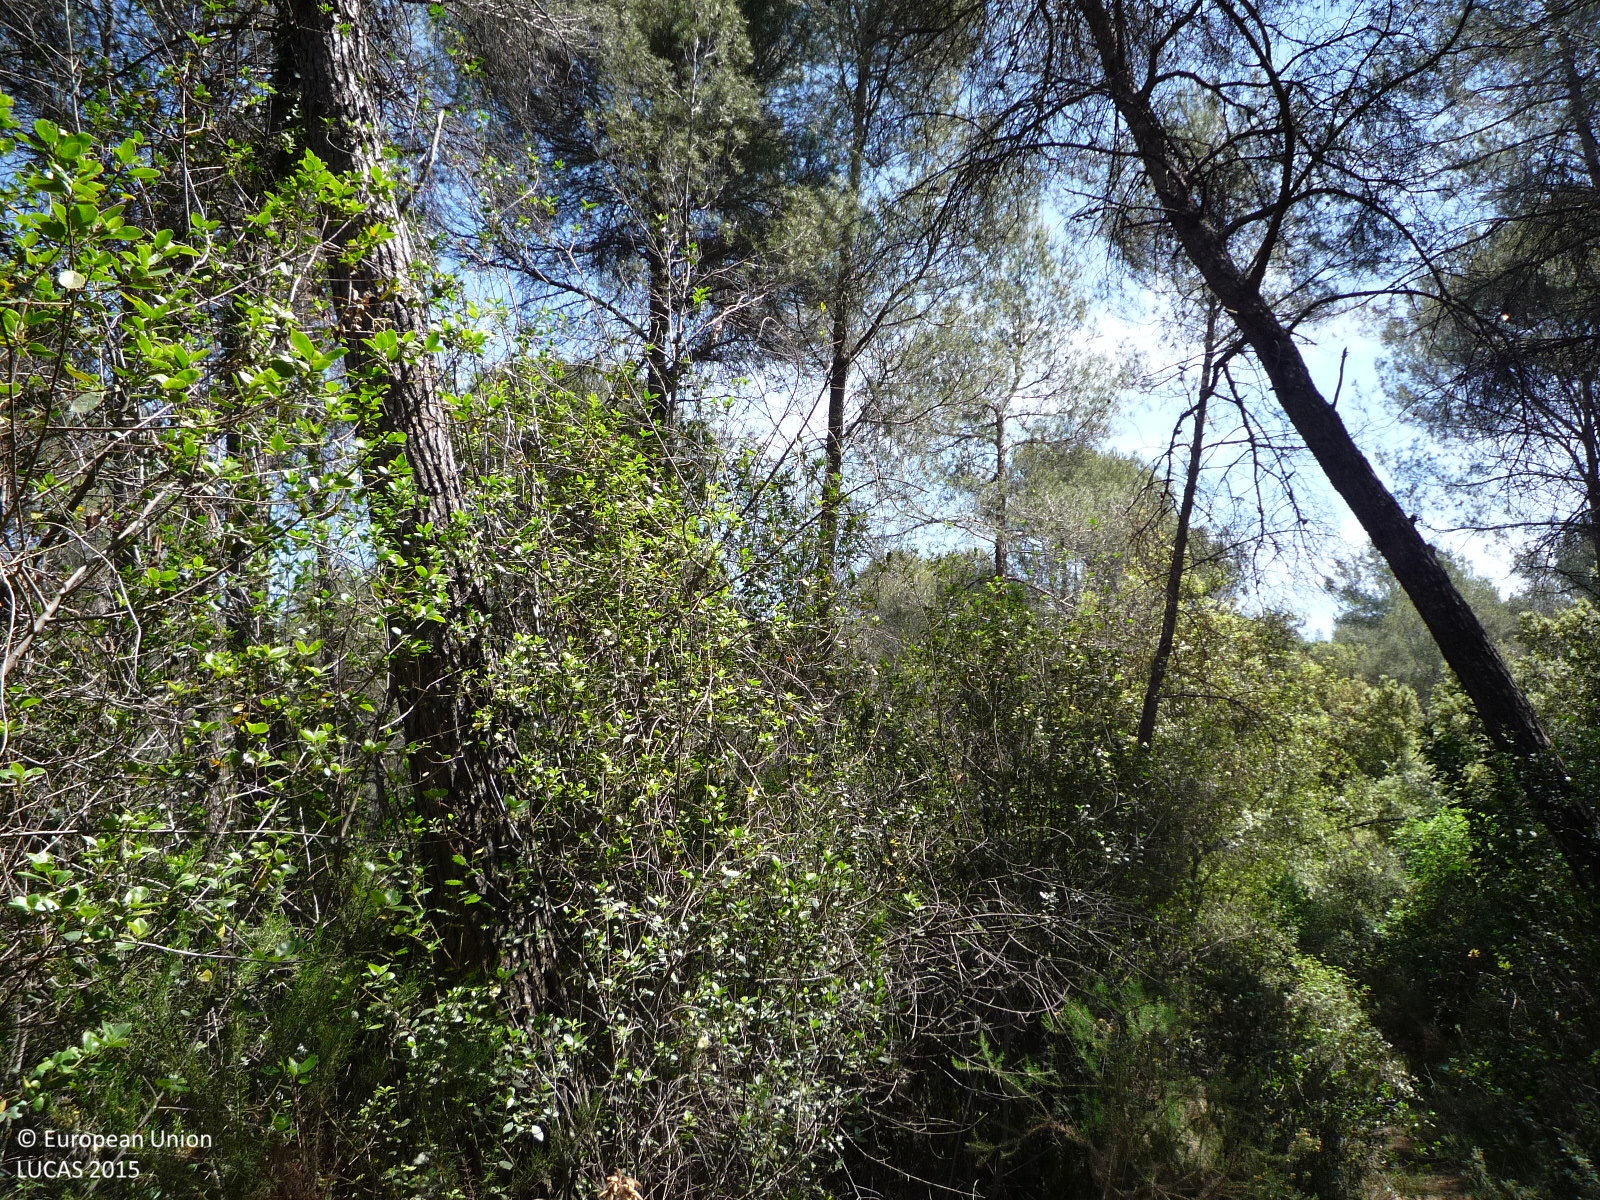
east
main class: Woodland
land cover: Pine dominated mixed woodland
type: coniferous forest of the mediterranean region
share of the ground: > 75 %
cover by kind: coniferous forest trees 75 %, broadleaved forest trees 25 %
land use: Semi-natural and natural areas not in use
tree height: > 5 m
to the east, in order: Pine dominated mixed woodland; Tracks; Pine dominated mixed woodland; Electric lines; Pine dominated coniferous woodland; Tracks; Shrubland with sparse tree cover; Pine dominated mixed woodland
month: May
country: ES
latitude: 41.5084
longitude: 2.0737
